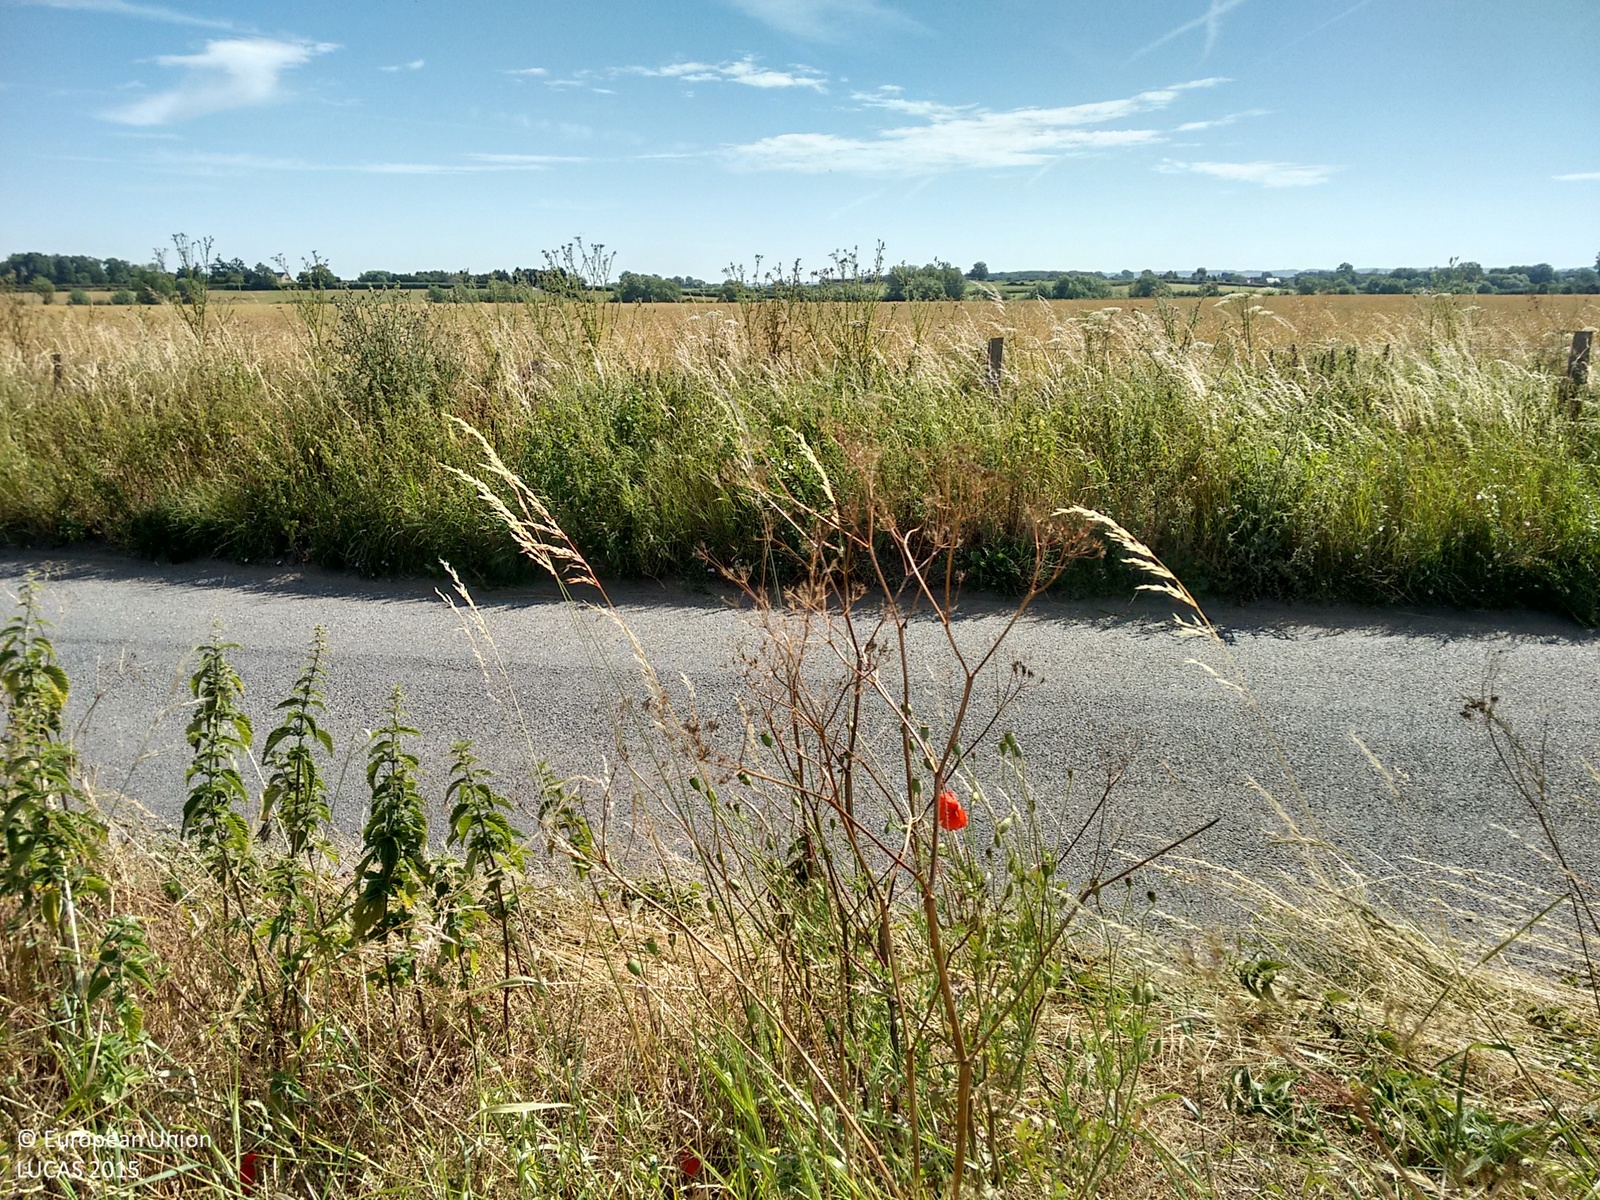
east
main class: Cropland
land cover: Rape and turnip rape
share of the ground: > 75 %
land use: Agriculture (excluding fallow land and kitchen gardens)
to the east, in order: Rape and turnip rape; Grass margins; Paved roads, cycling and walking lanes; Grass margins; Fences; Rape and turnip rape
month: July
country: GB
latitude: 51.6701
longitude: -1.1367
